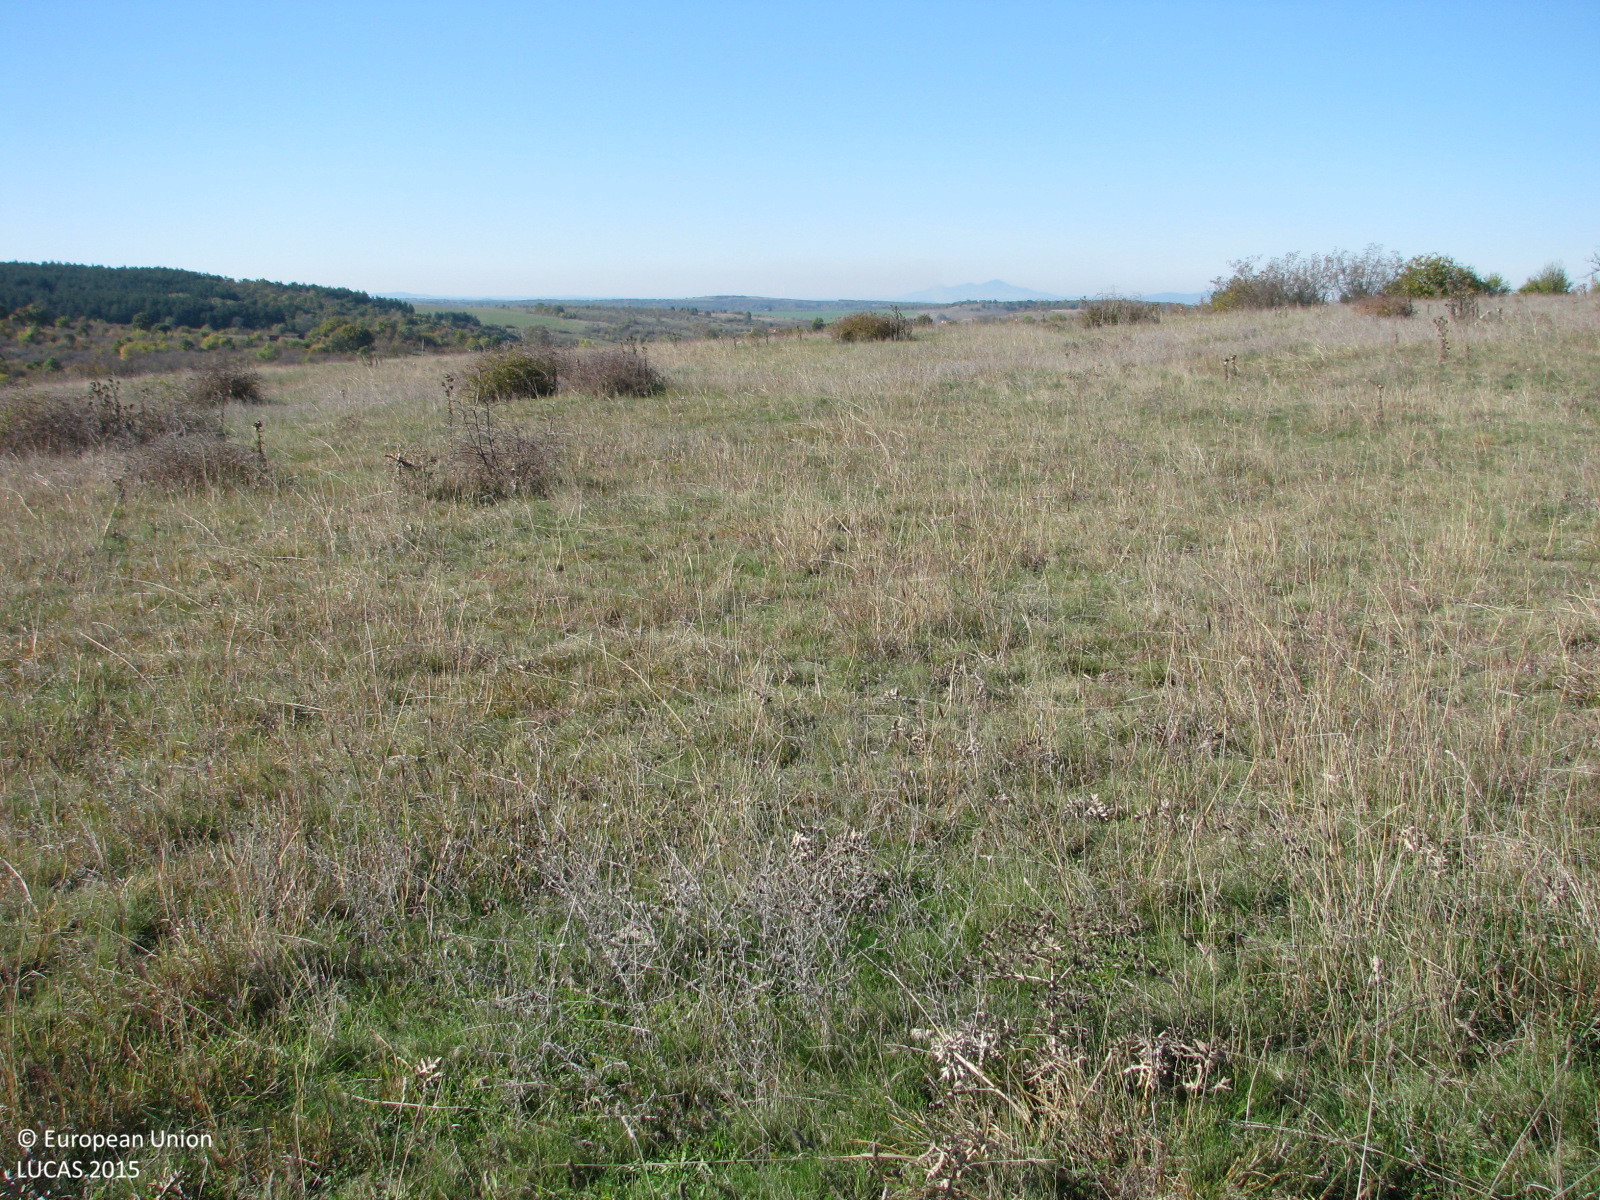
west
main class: Grassland
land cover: Grassland without tree/shrub cover
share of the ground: > 75 %
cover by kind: herbaceous plants 95 %, shrubs 5 %
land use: Agriculture (excluding fallow land and kitchen gardens)
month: November
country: BG
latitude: 42.0723
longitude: 26.6611
